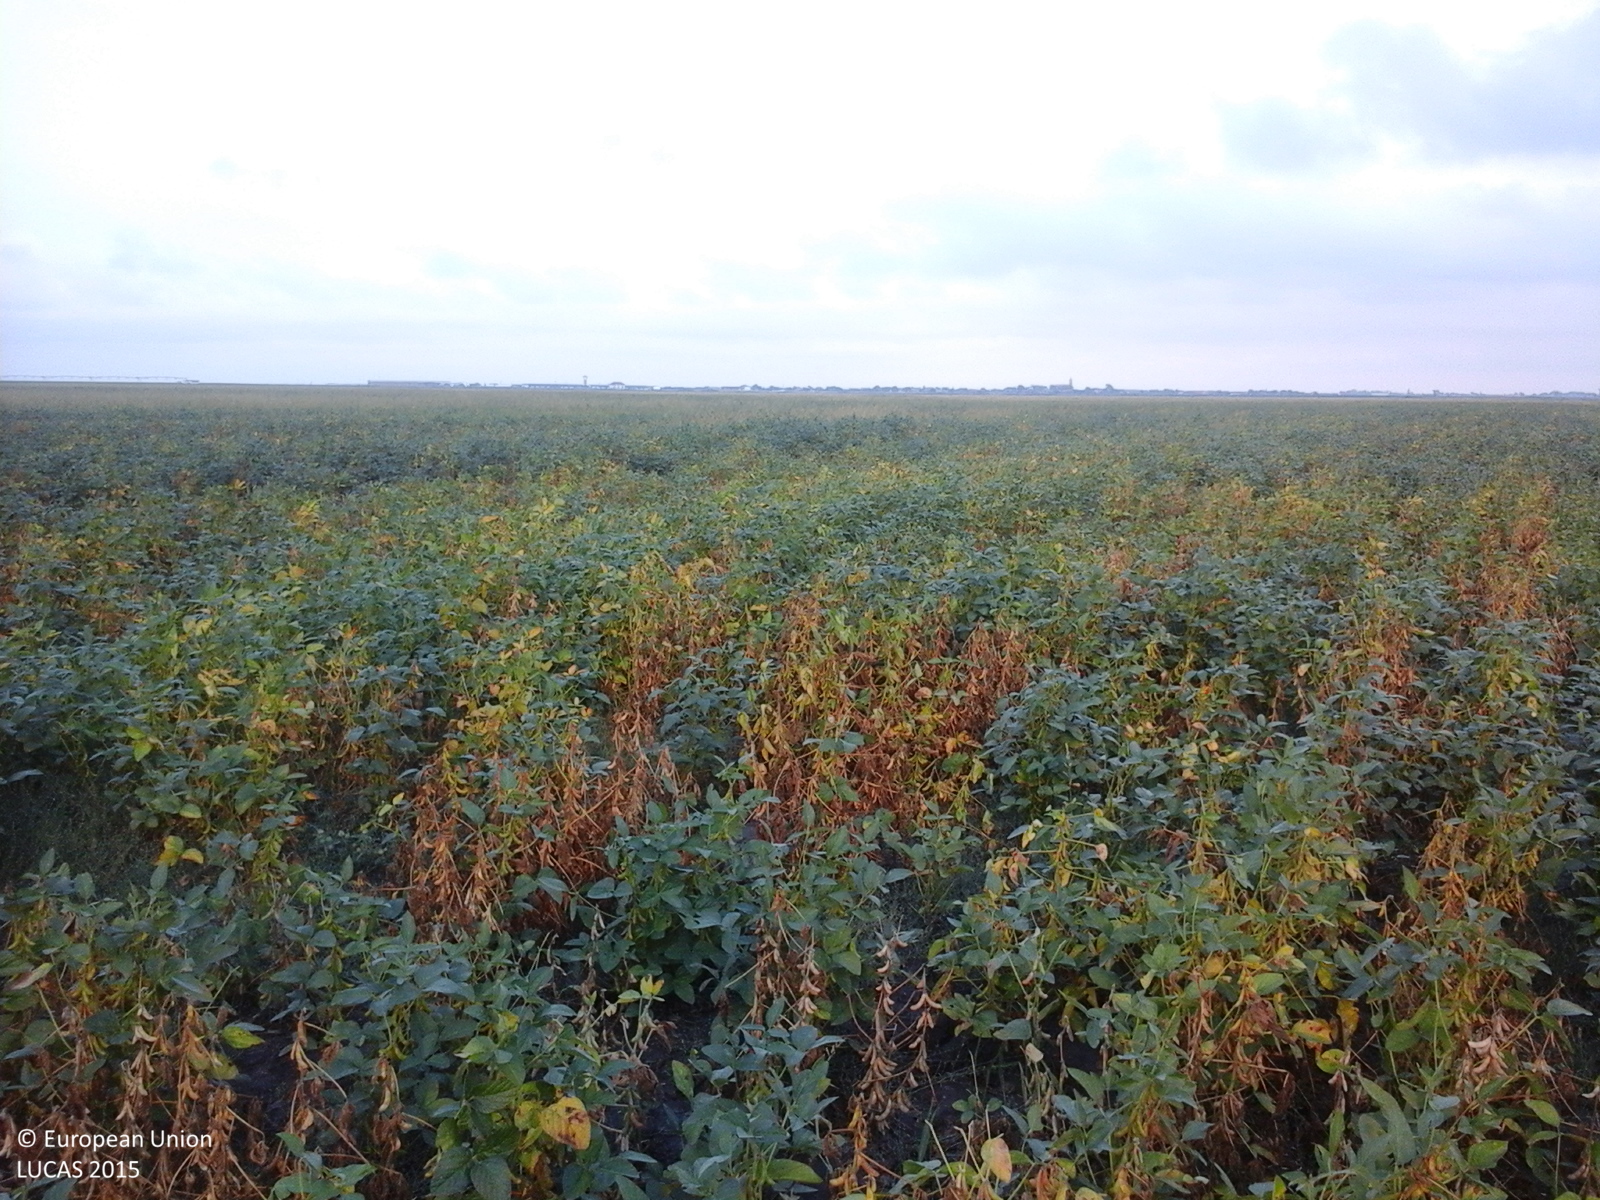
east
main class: Cropland
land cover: Soya
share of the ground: > 75 %
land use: Agriculture (excluding fallow land and kitchen gardens)
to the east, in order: Soya
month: August
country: RO
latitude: 45.9637
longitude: 20.4629
